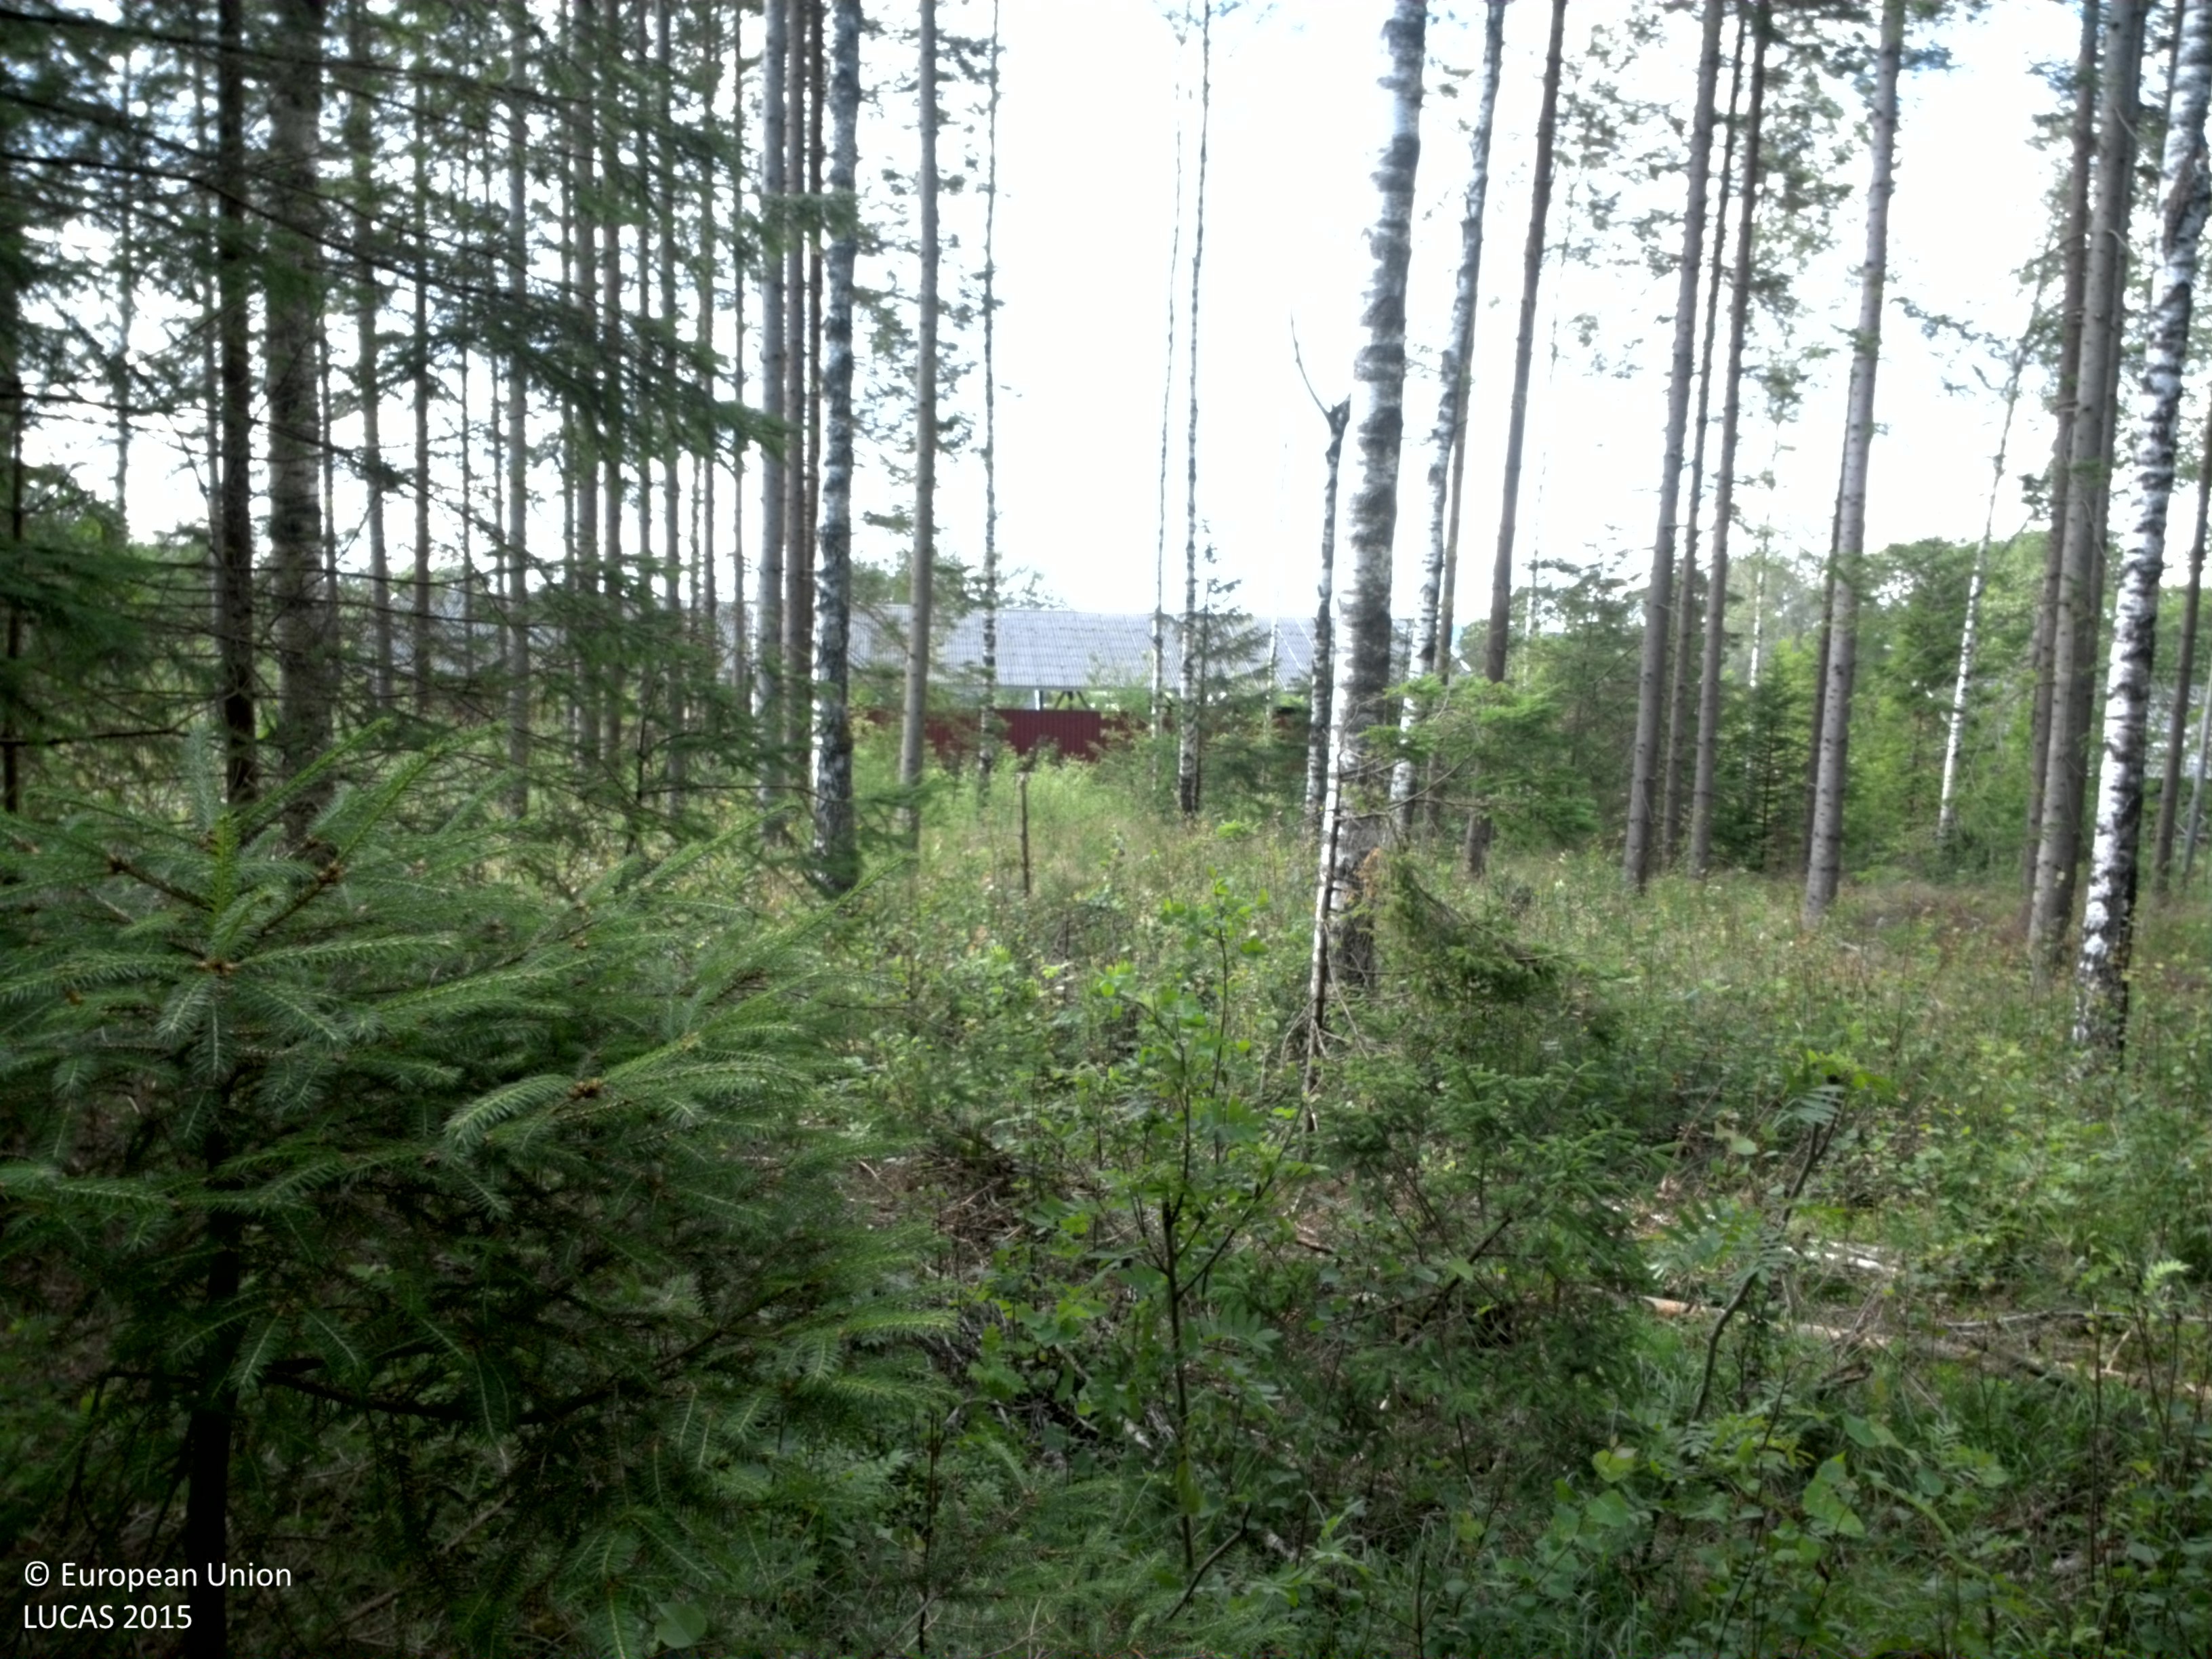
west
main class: Woodland
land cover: Spruce dominated mixed woodland
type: boreal forest
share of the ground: 50 - 75 %
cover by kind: broadleaved forest trees 35 %, coniferous forest trees 30 %, shrubs 15 %, herbaceous plants 10 %, lichens and mosses 10 %
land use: Forestry
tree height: > 5 m
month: July
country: SE
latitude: 58.1813
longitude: 13.8885
